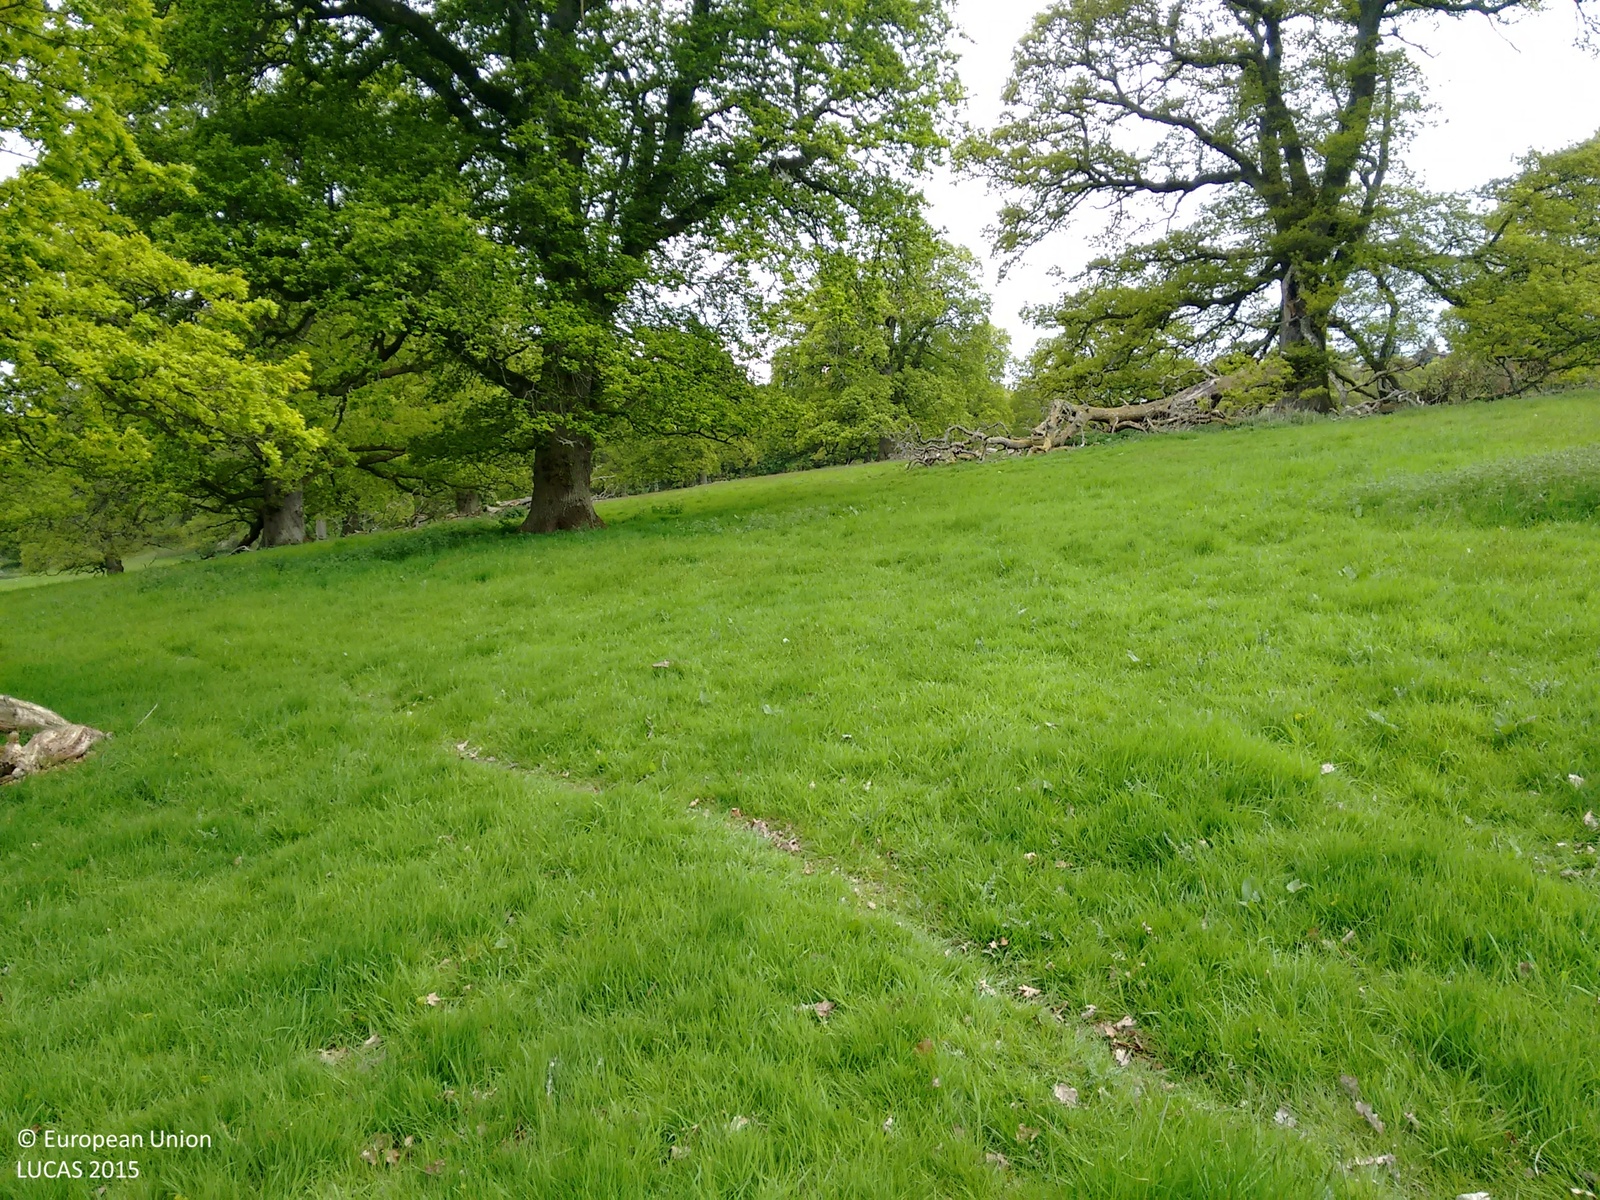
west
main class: Woodland
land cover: Broadleaved woodland
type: exotic forest
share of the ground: 10 - 25 %
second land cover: Grassland without tree/shrub cover
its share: > 75 %
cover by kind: herbaceous plants 80 %, broadleaved forest trees 20 %
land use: Agriculture (excluding fallow land and kitchen gardens)
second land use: Forestry
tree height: > 5 m
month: May
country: GB
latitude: 56.3619
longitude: -3.5272
